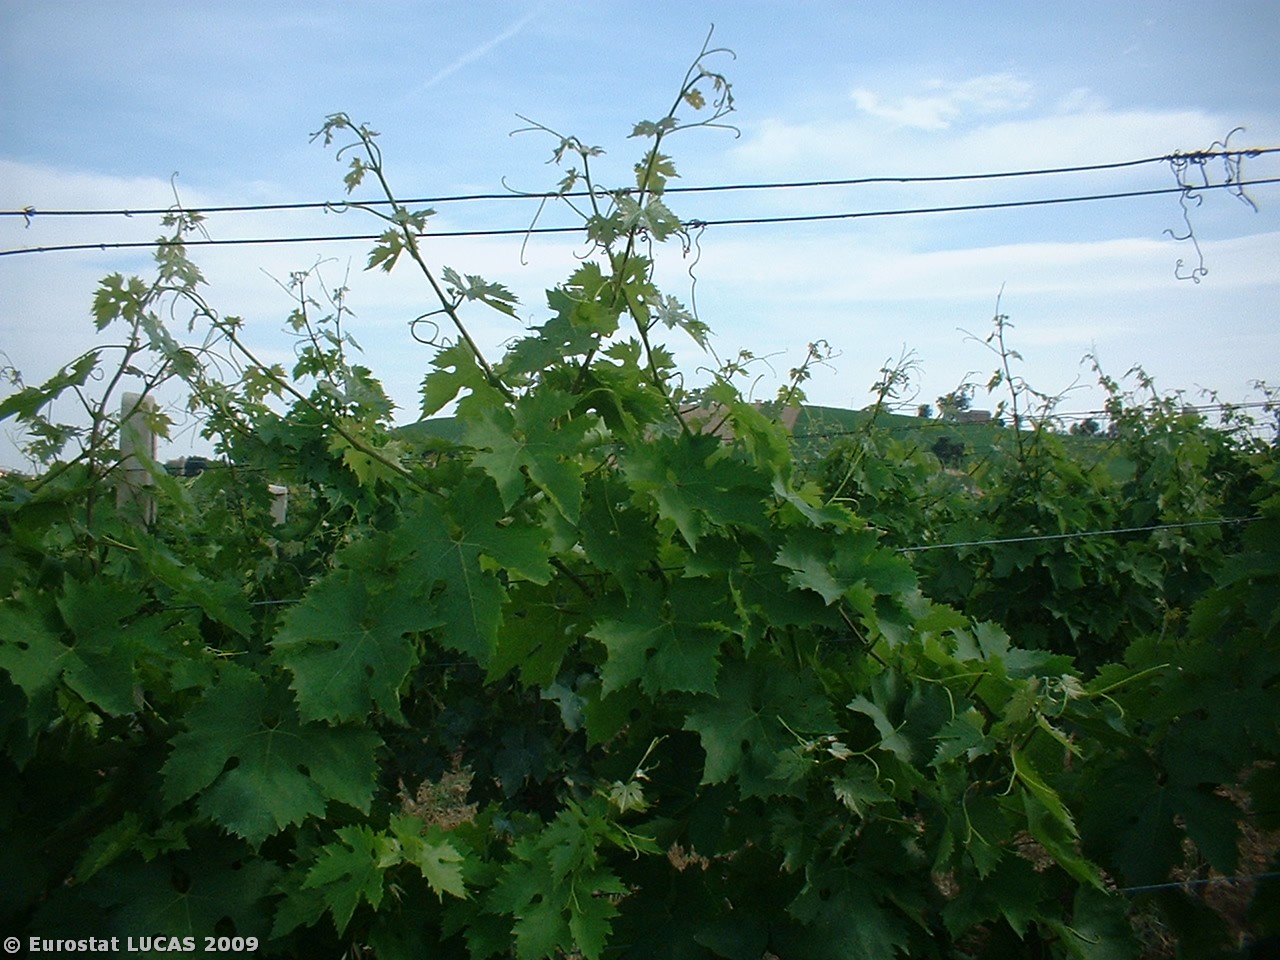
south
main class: Cropland
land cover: Vineyards
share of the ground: 25 - 50 %
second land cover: Bare land
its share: > 75 %
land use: Agriculture (excluding fallow land and kitchen gardens)
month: June
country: IT
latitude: 42.9289
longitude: 13.7268
